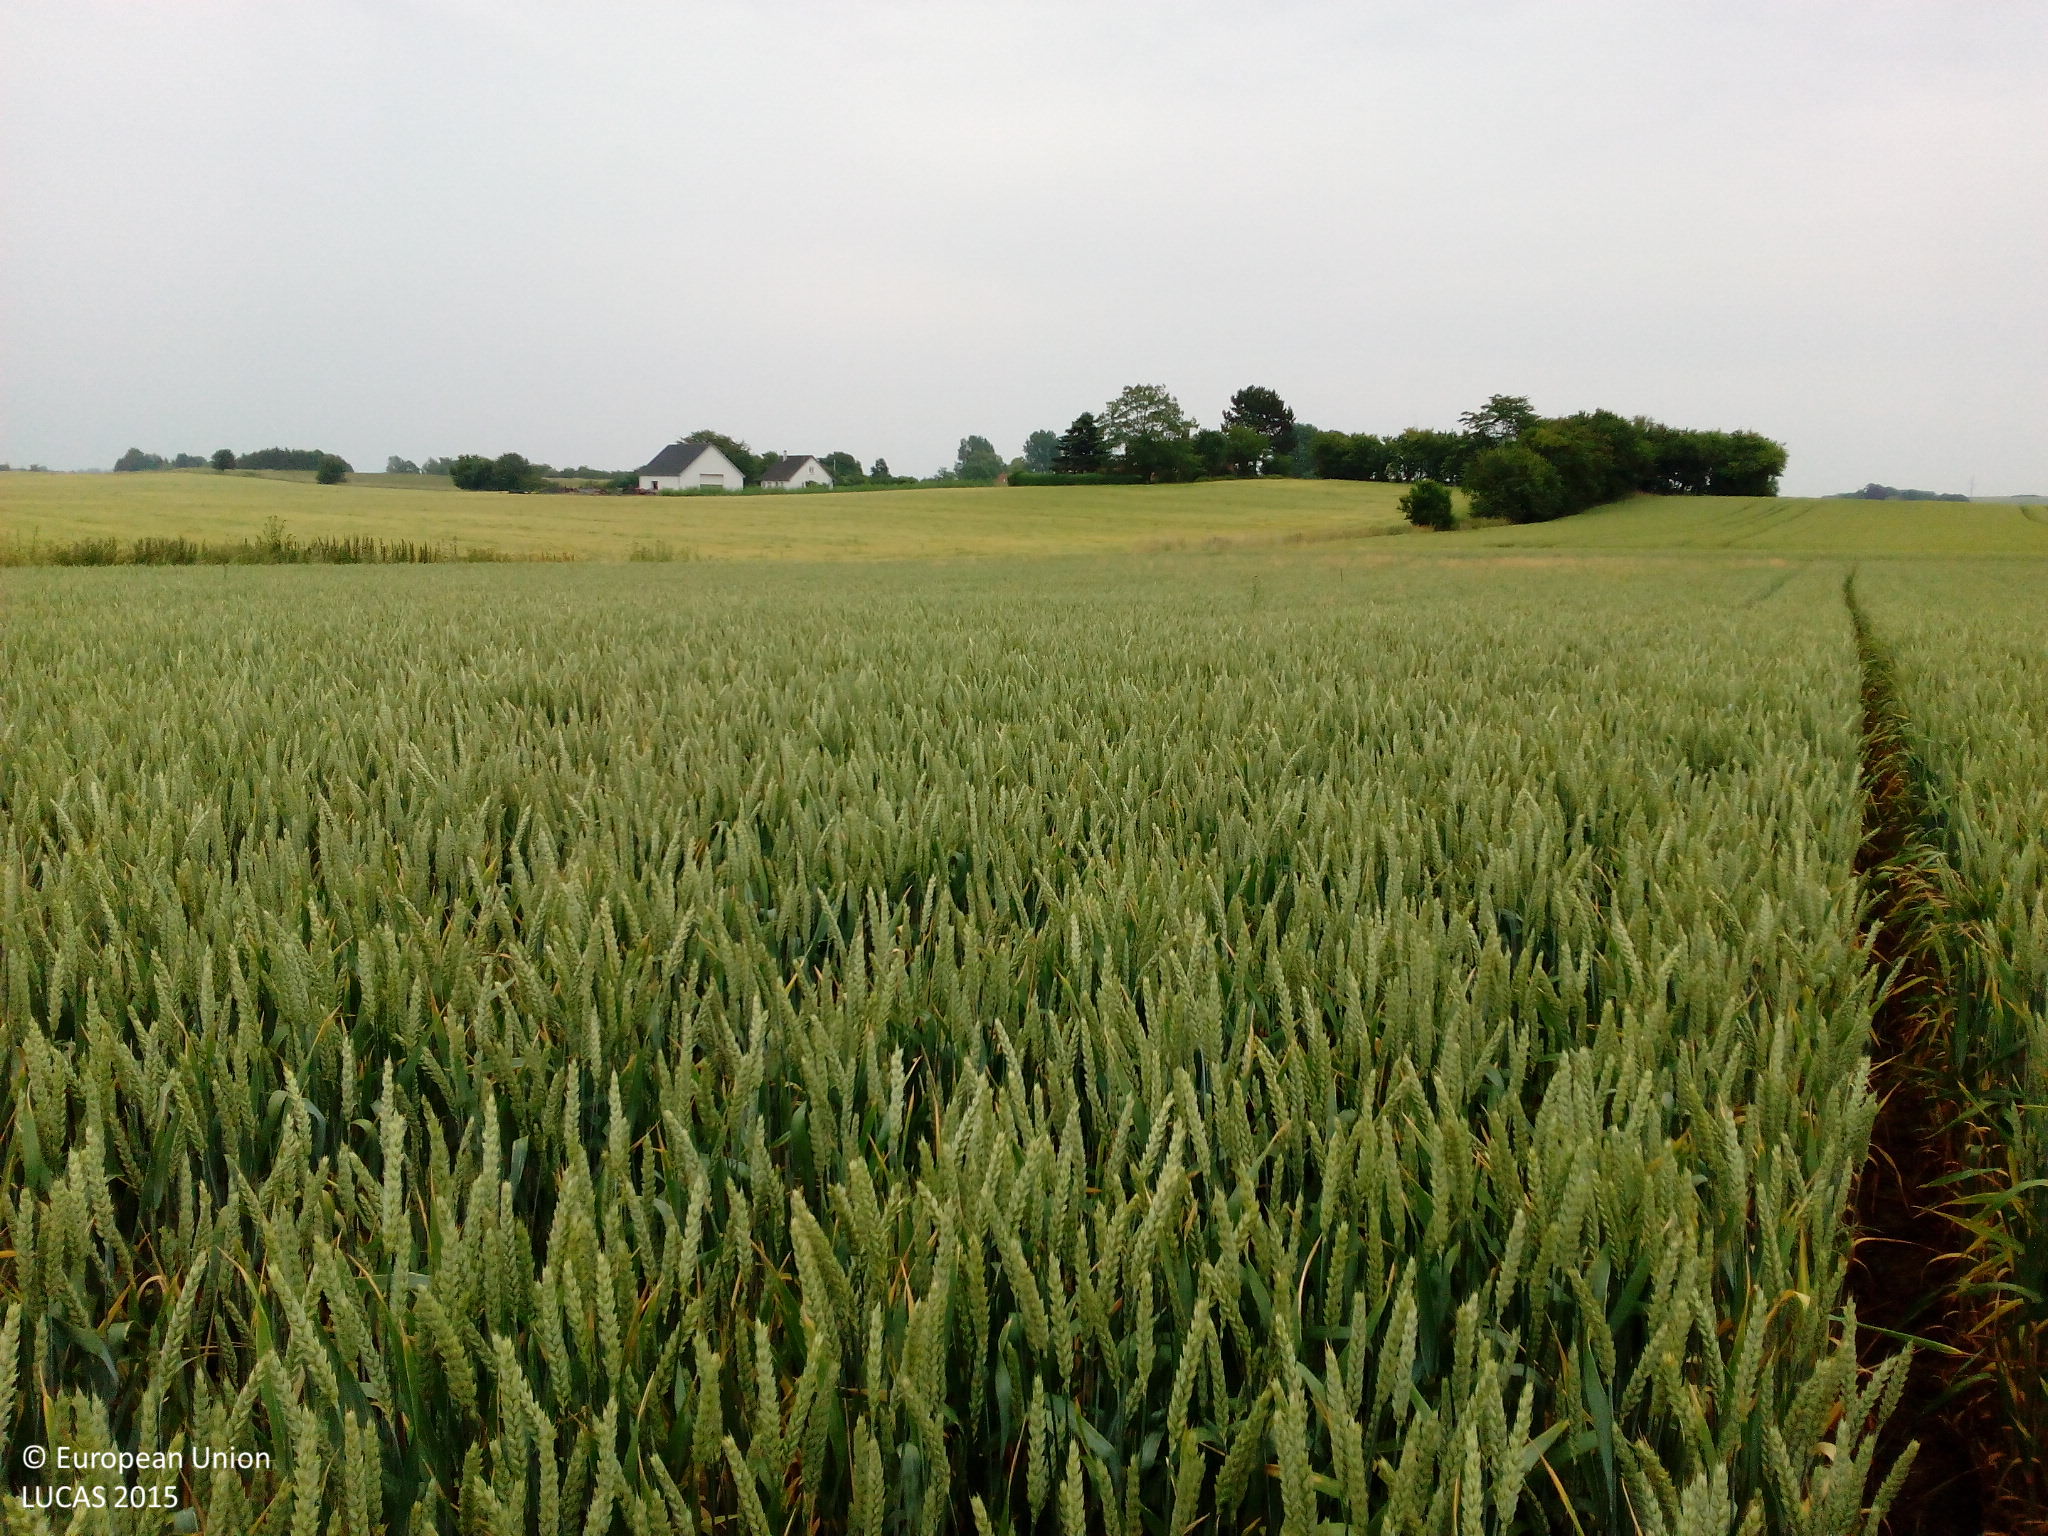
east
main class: Cropland
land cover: Common wheat
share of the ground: > 75 %
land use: Agriculture (excluding fallow land and kitchen gardens)
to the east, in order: Common wheat; Shruby margins; Barley; Artificial constructions in urban areas; Grass margins; Common wheat
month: July
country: DK
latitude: 55.2255
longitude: 11.5552
